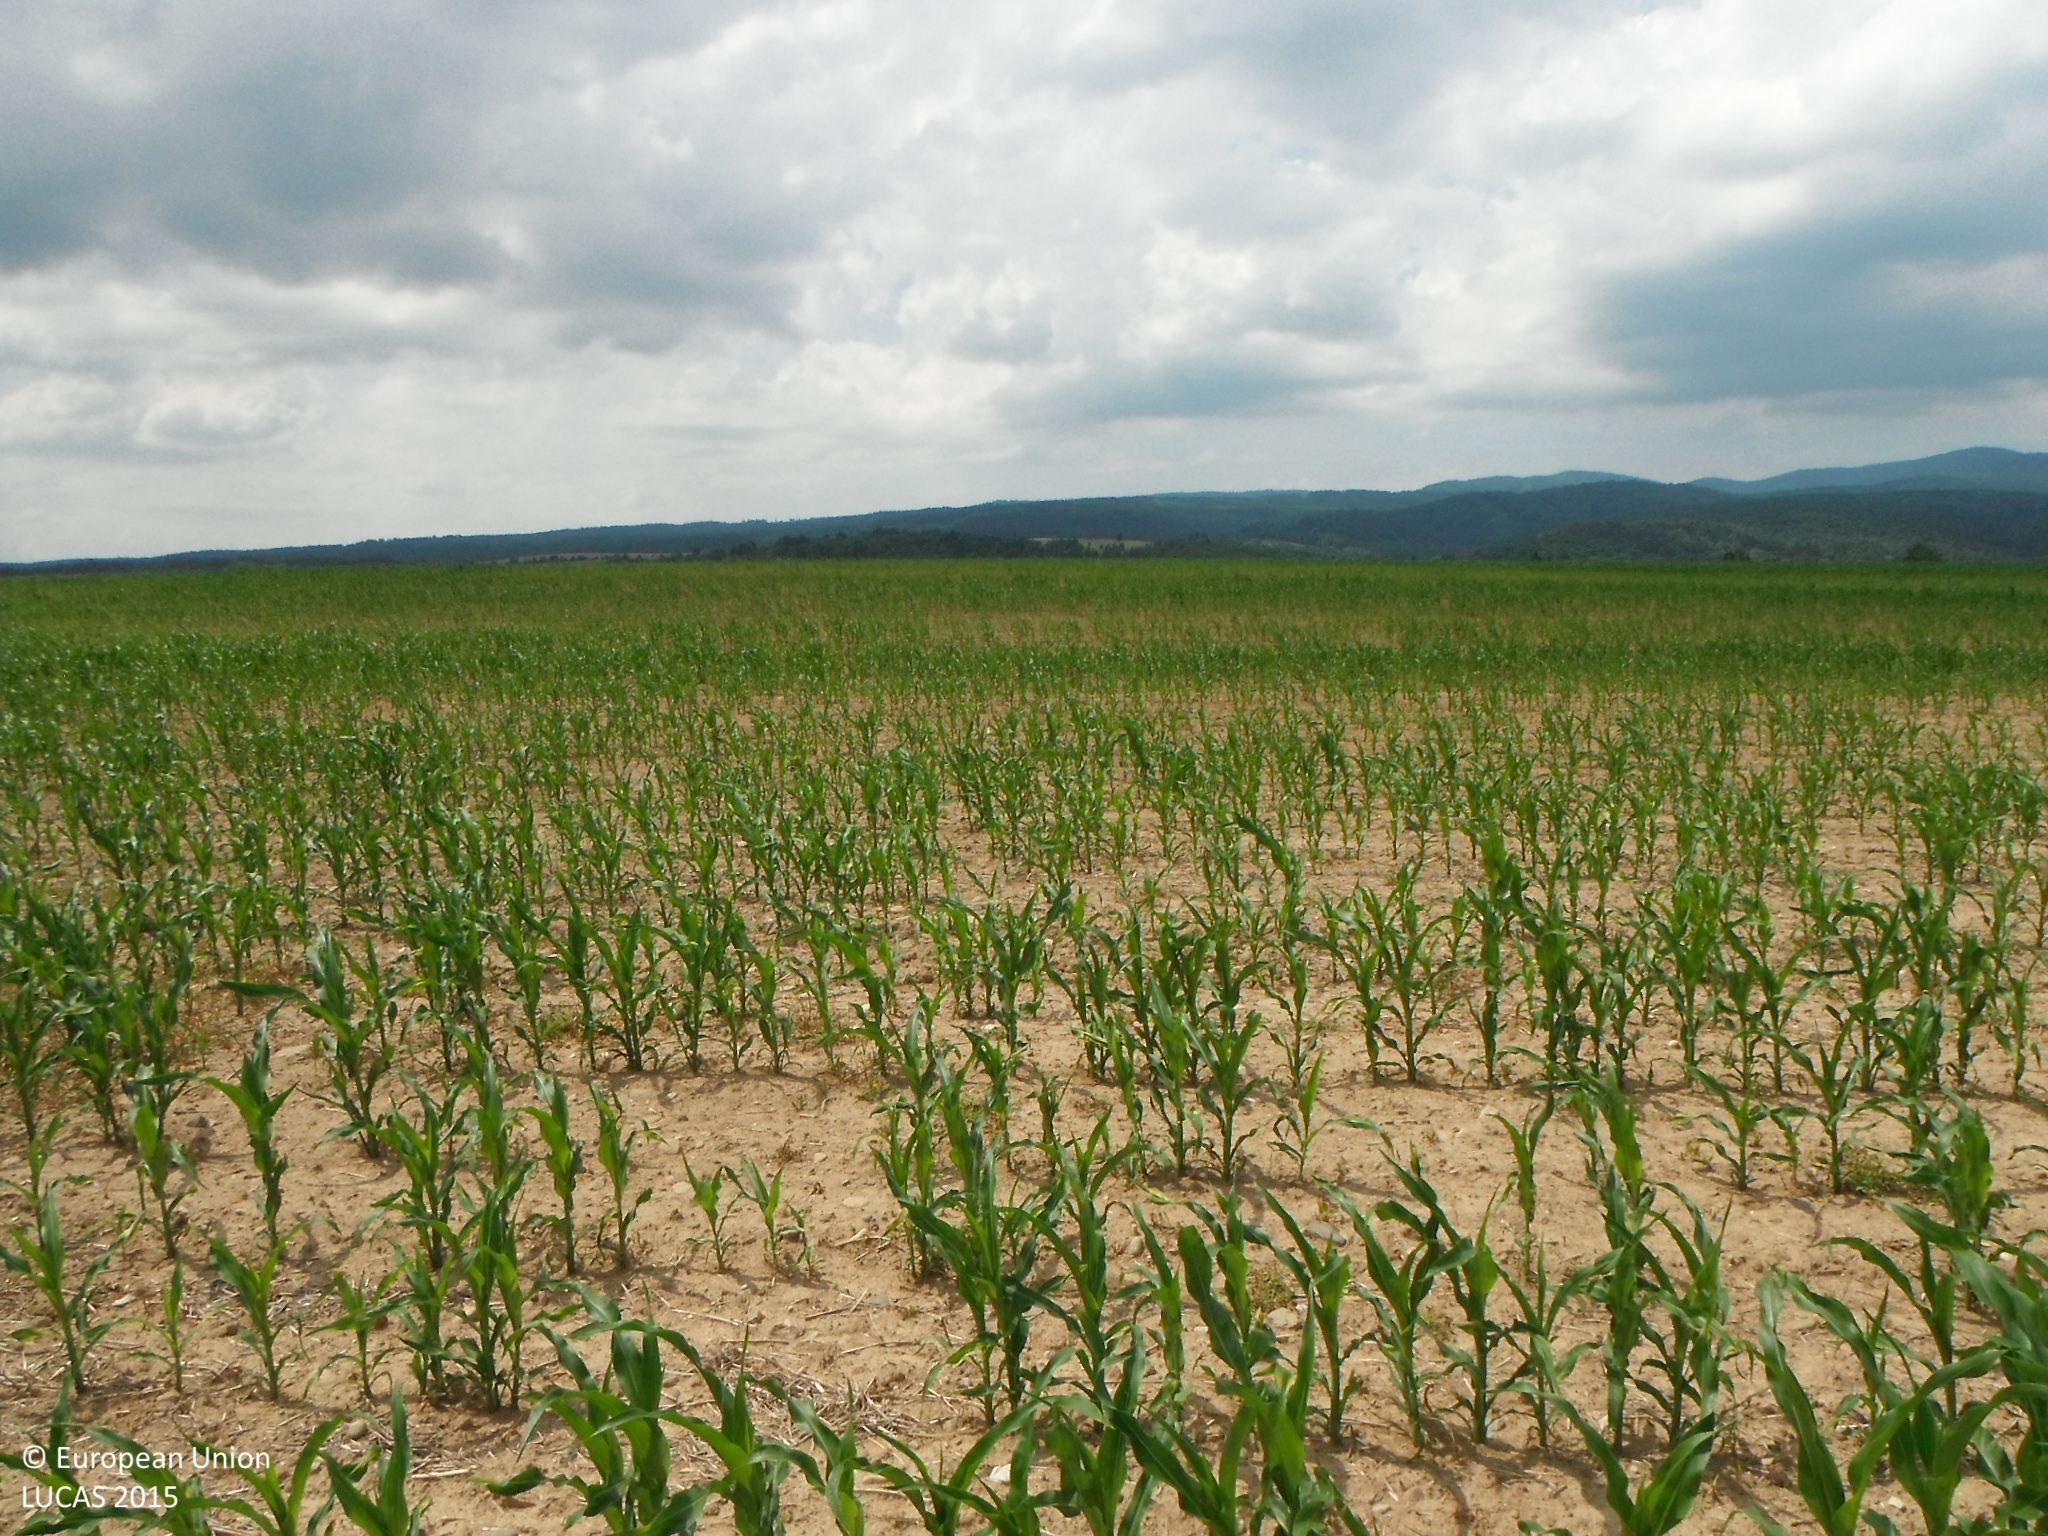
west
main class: Cropland
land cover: Maize
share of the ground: 25 - 50 %
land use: Agriculture (excluding fallow land and kitchen gardens)
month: June
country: SK
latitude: 48.6408
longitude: 19.1283
